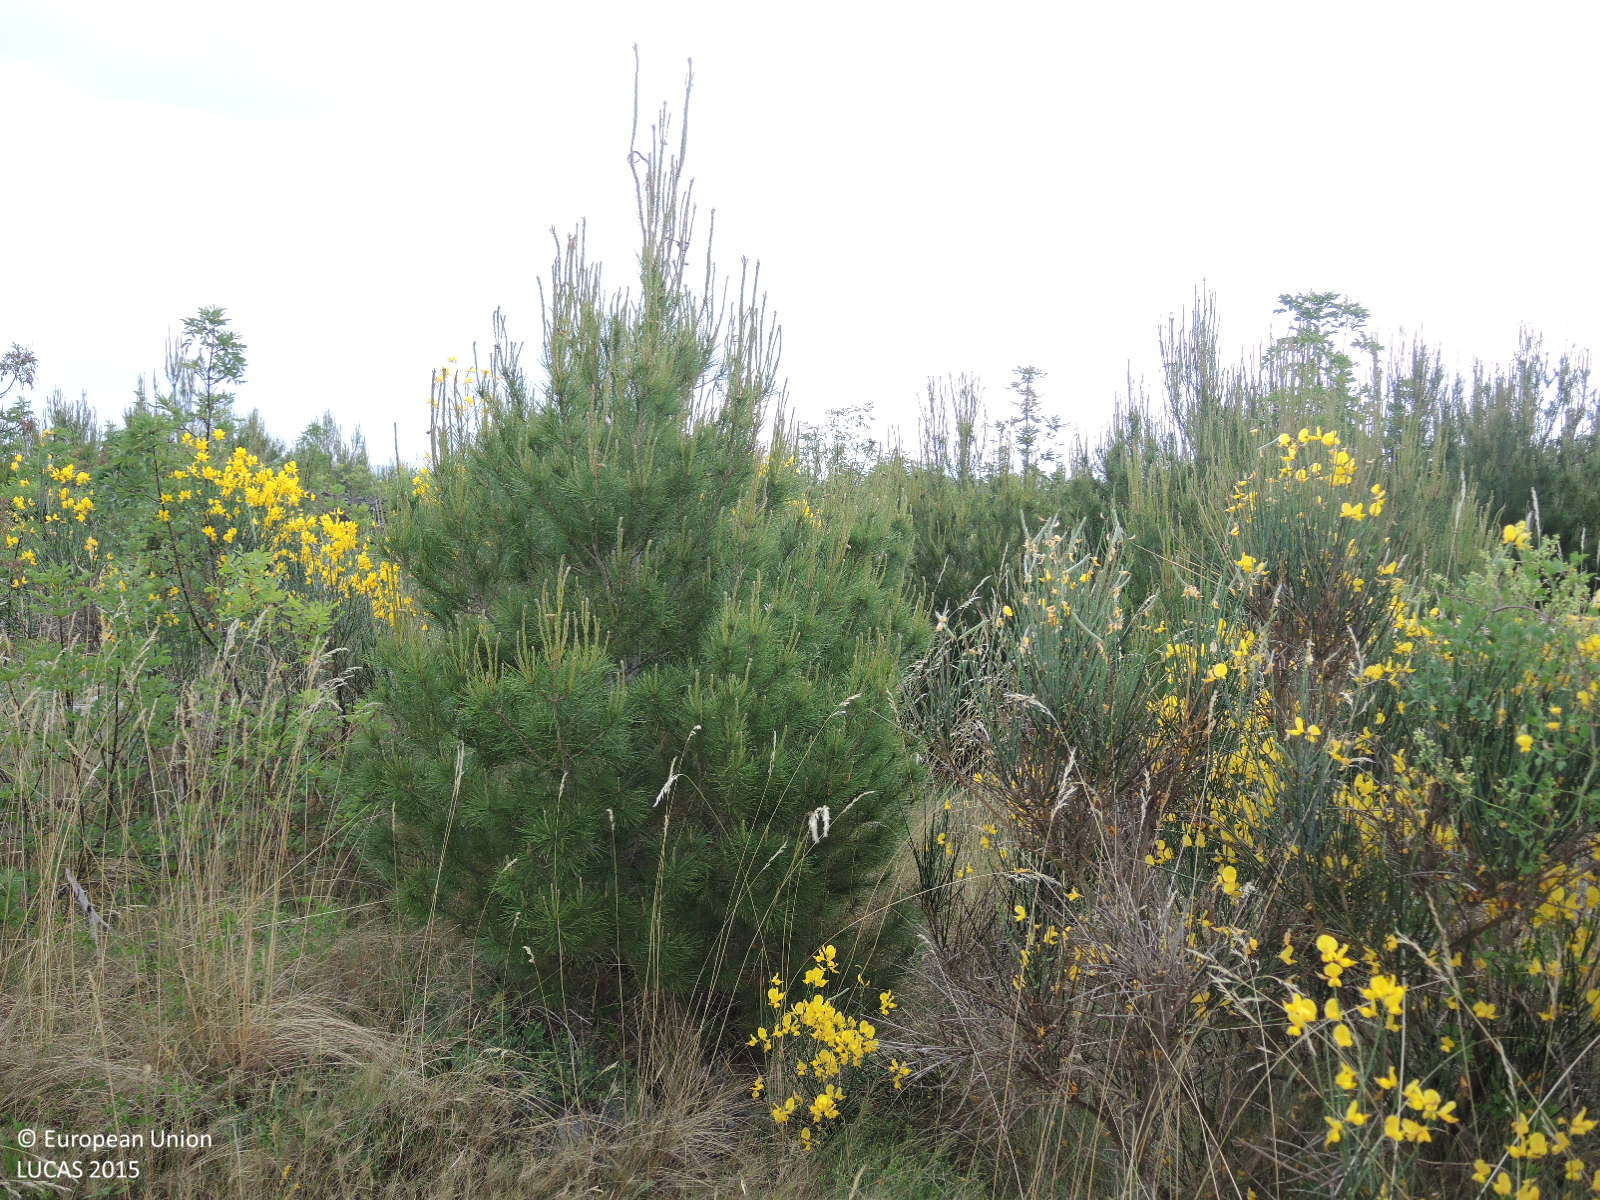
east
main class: Woodland
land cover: Pine dominated coniferous woodland
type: coniferous forest of the mediterranean region
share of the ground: 10 - 25 %
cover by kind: herbaceous plants 60 %, shrubs 20 %, coniferous forest trees 15 %, unconsolidated bare surface 5 %
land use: Semi-natural and natural areas not in use
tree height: < 5 m
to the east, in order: Pine dominated coniferous woodland; Dry stone walls; Shrubland with sparse tree cover; Artificial constructions; Shrubland with sparse tree cover; Dry stone walls; Shrubland with sparse tree cover; Dry stone walls; Tracks; Dry stone walls; Shrubland without tree cover; Artificial constructions; Shrubland with sparse tree cover; Dry stone walls; Shrubland with sparse tree cover; Dry stone walls; Shrubland with sparse tree cover; Dry stone walls
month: May
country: HR
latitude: 43.7341
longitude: 15.8387
